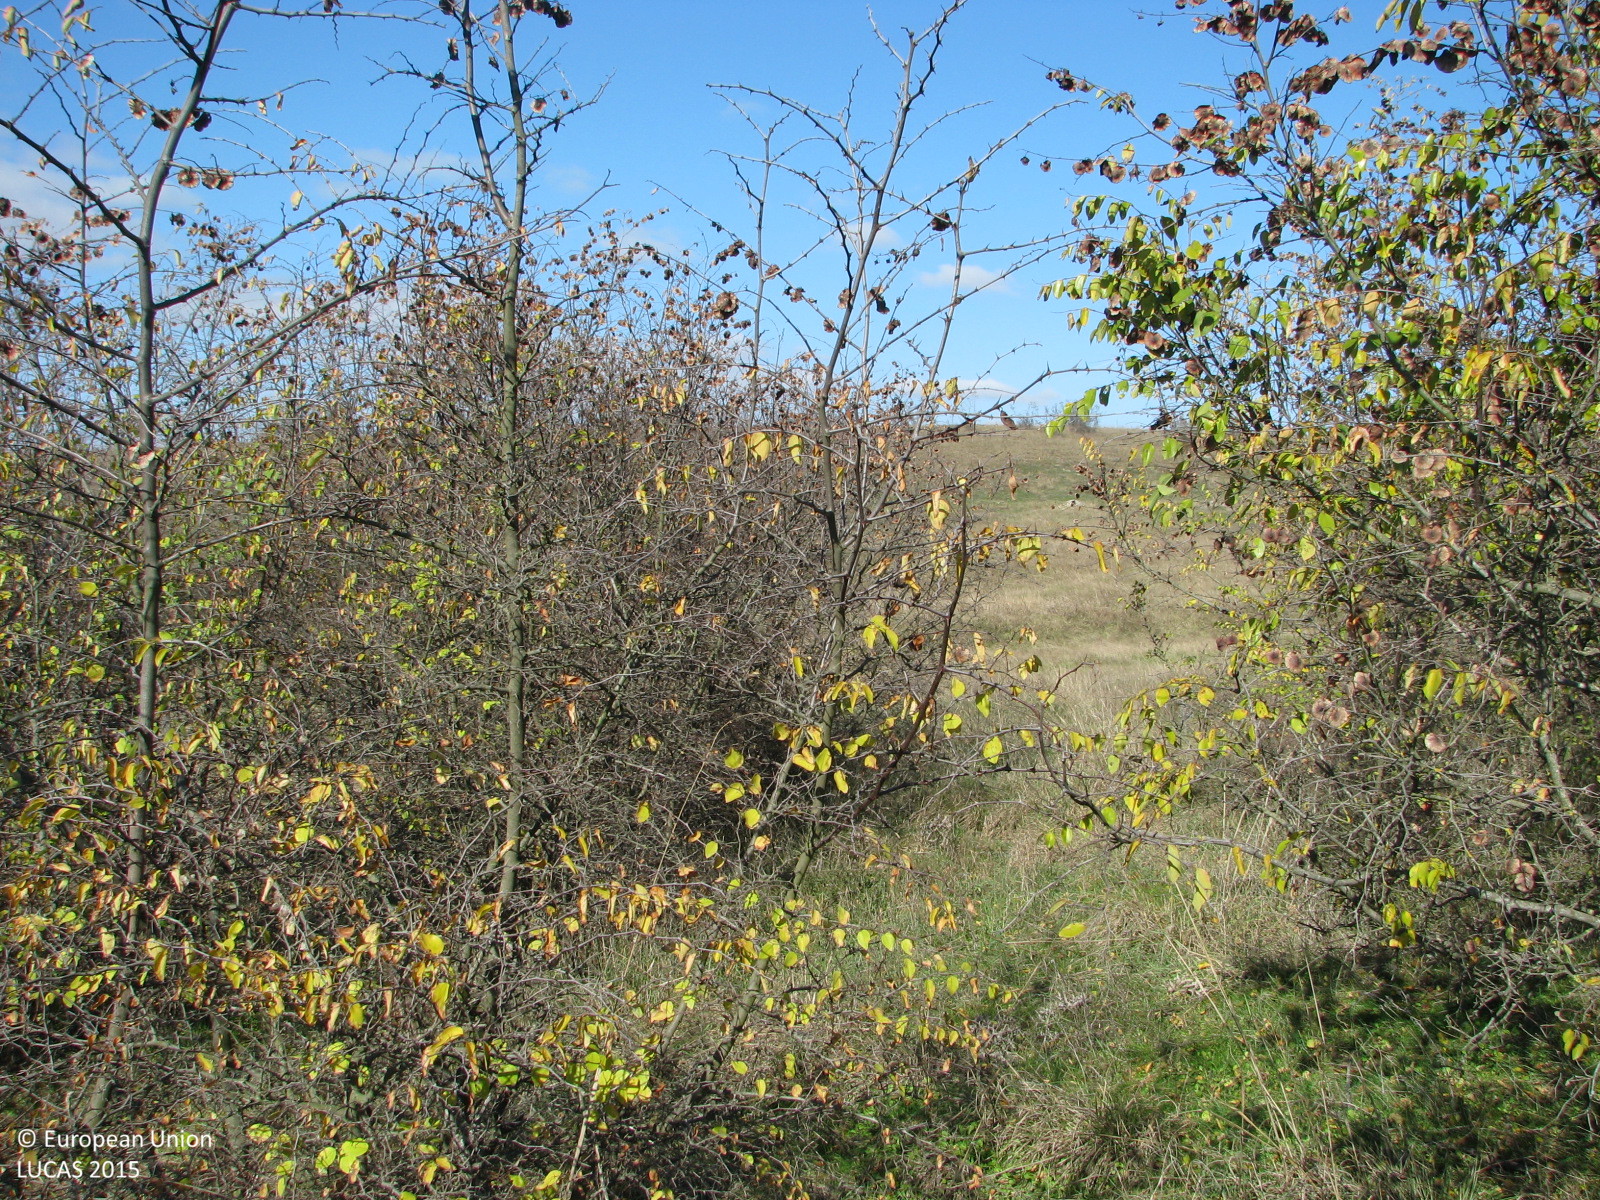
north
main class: Shrubland
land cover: Shrubland without tree cover
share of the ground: 25 - 50 %
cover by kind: herbaceous plants 55 %, shrubs 45 %
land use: Agriculture (excluding fallow land and kitchen gardens)
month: November
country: BG
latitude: 42.1000
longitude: 26.4954
